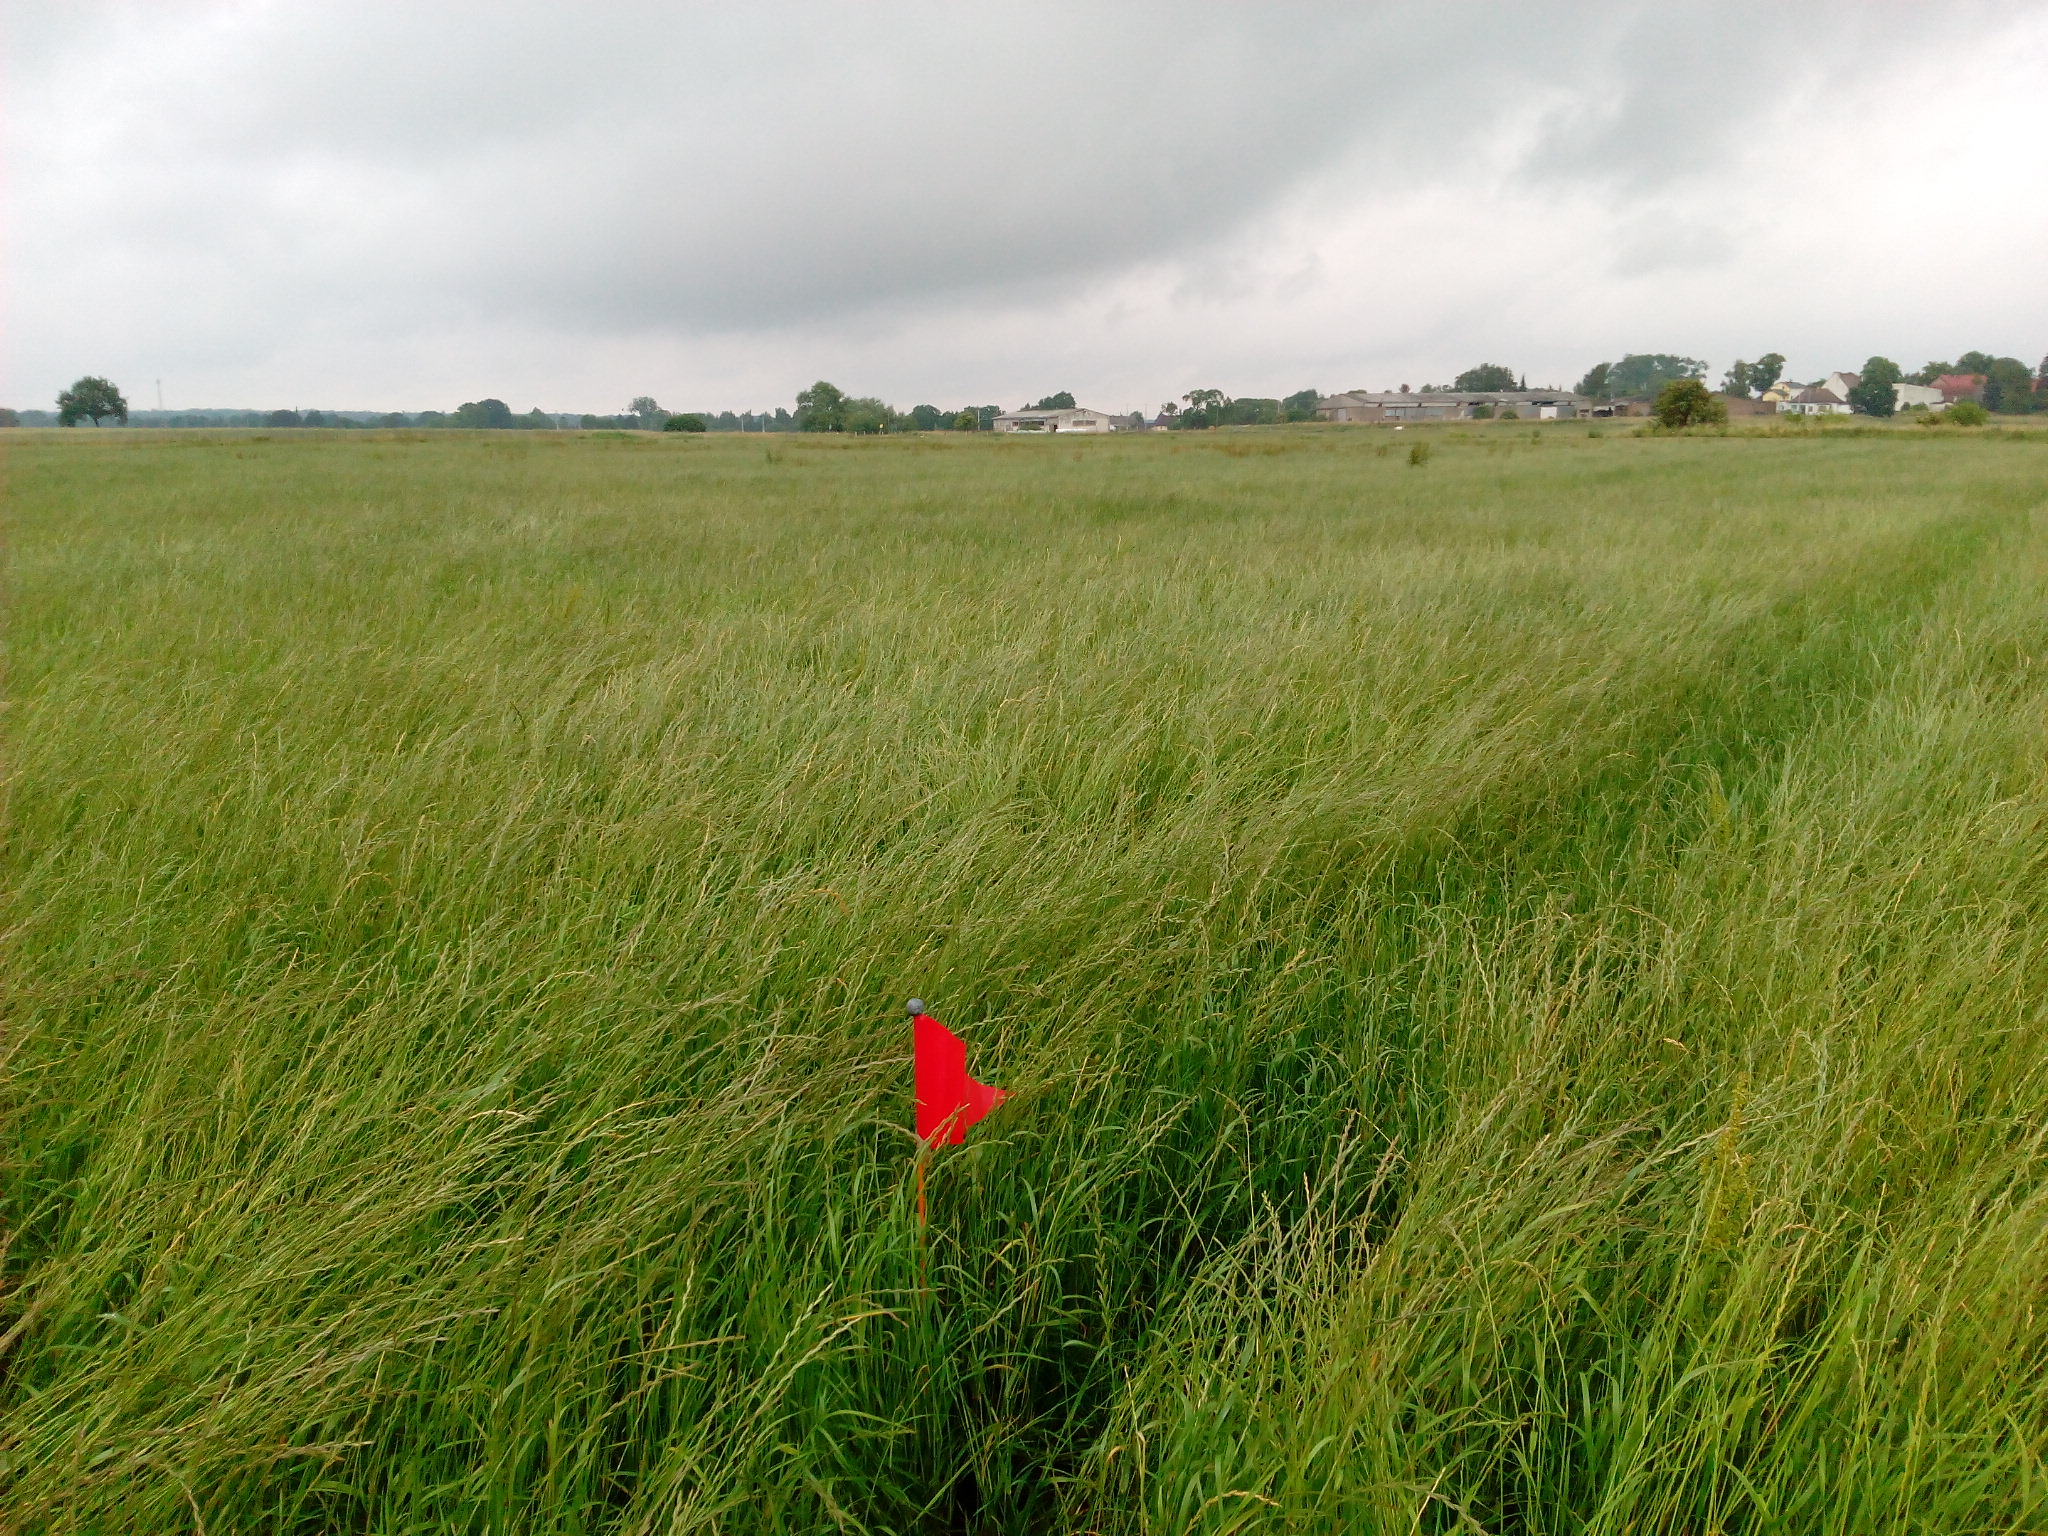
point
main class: Cropland
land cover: Temporary grasslands
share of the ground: > 75 %
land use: Agriculture (excluding fallow land and kitchen gardens)
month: June
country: DE
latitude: 53.0365
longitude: 13.1763
